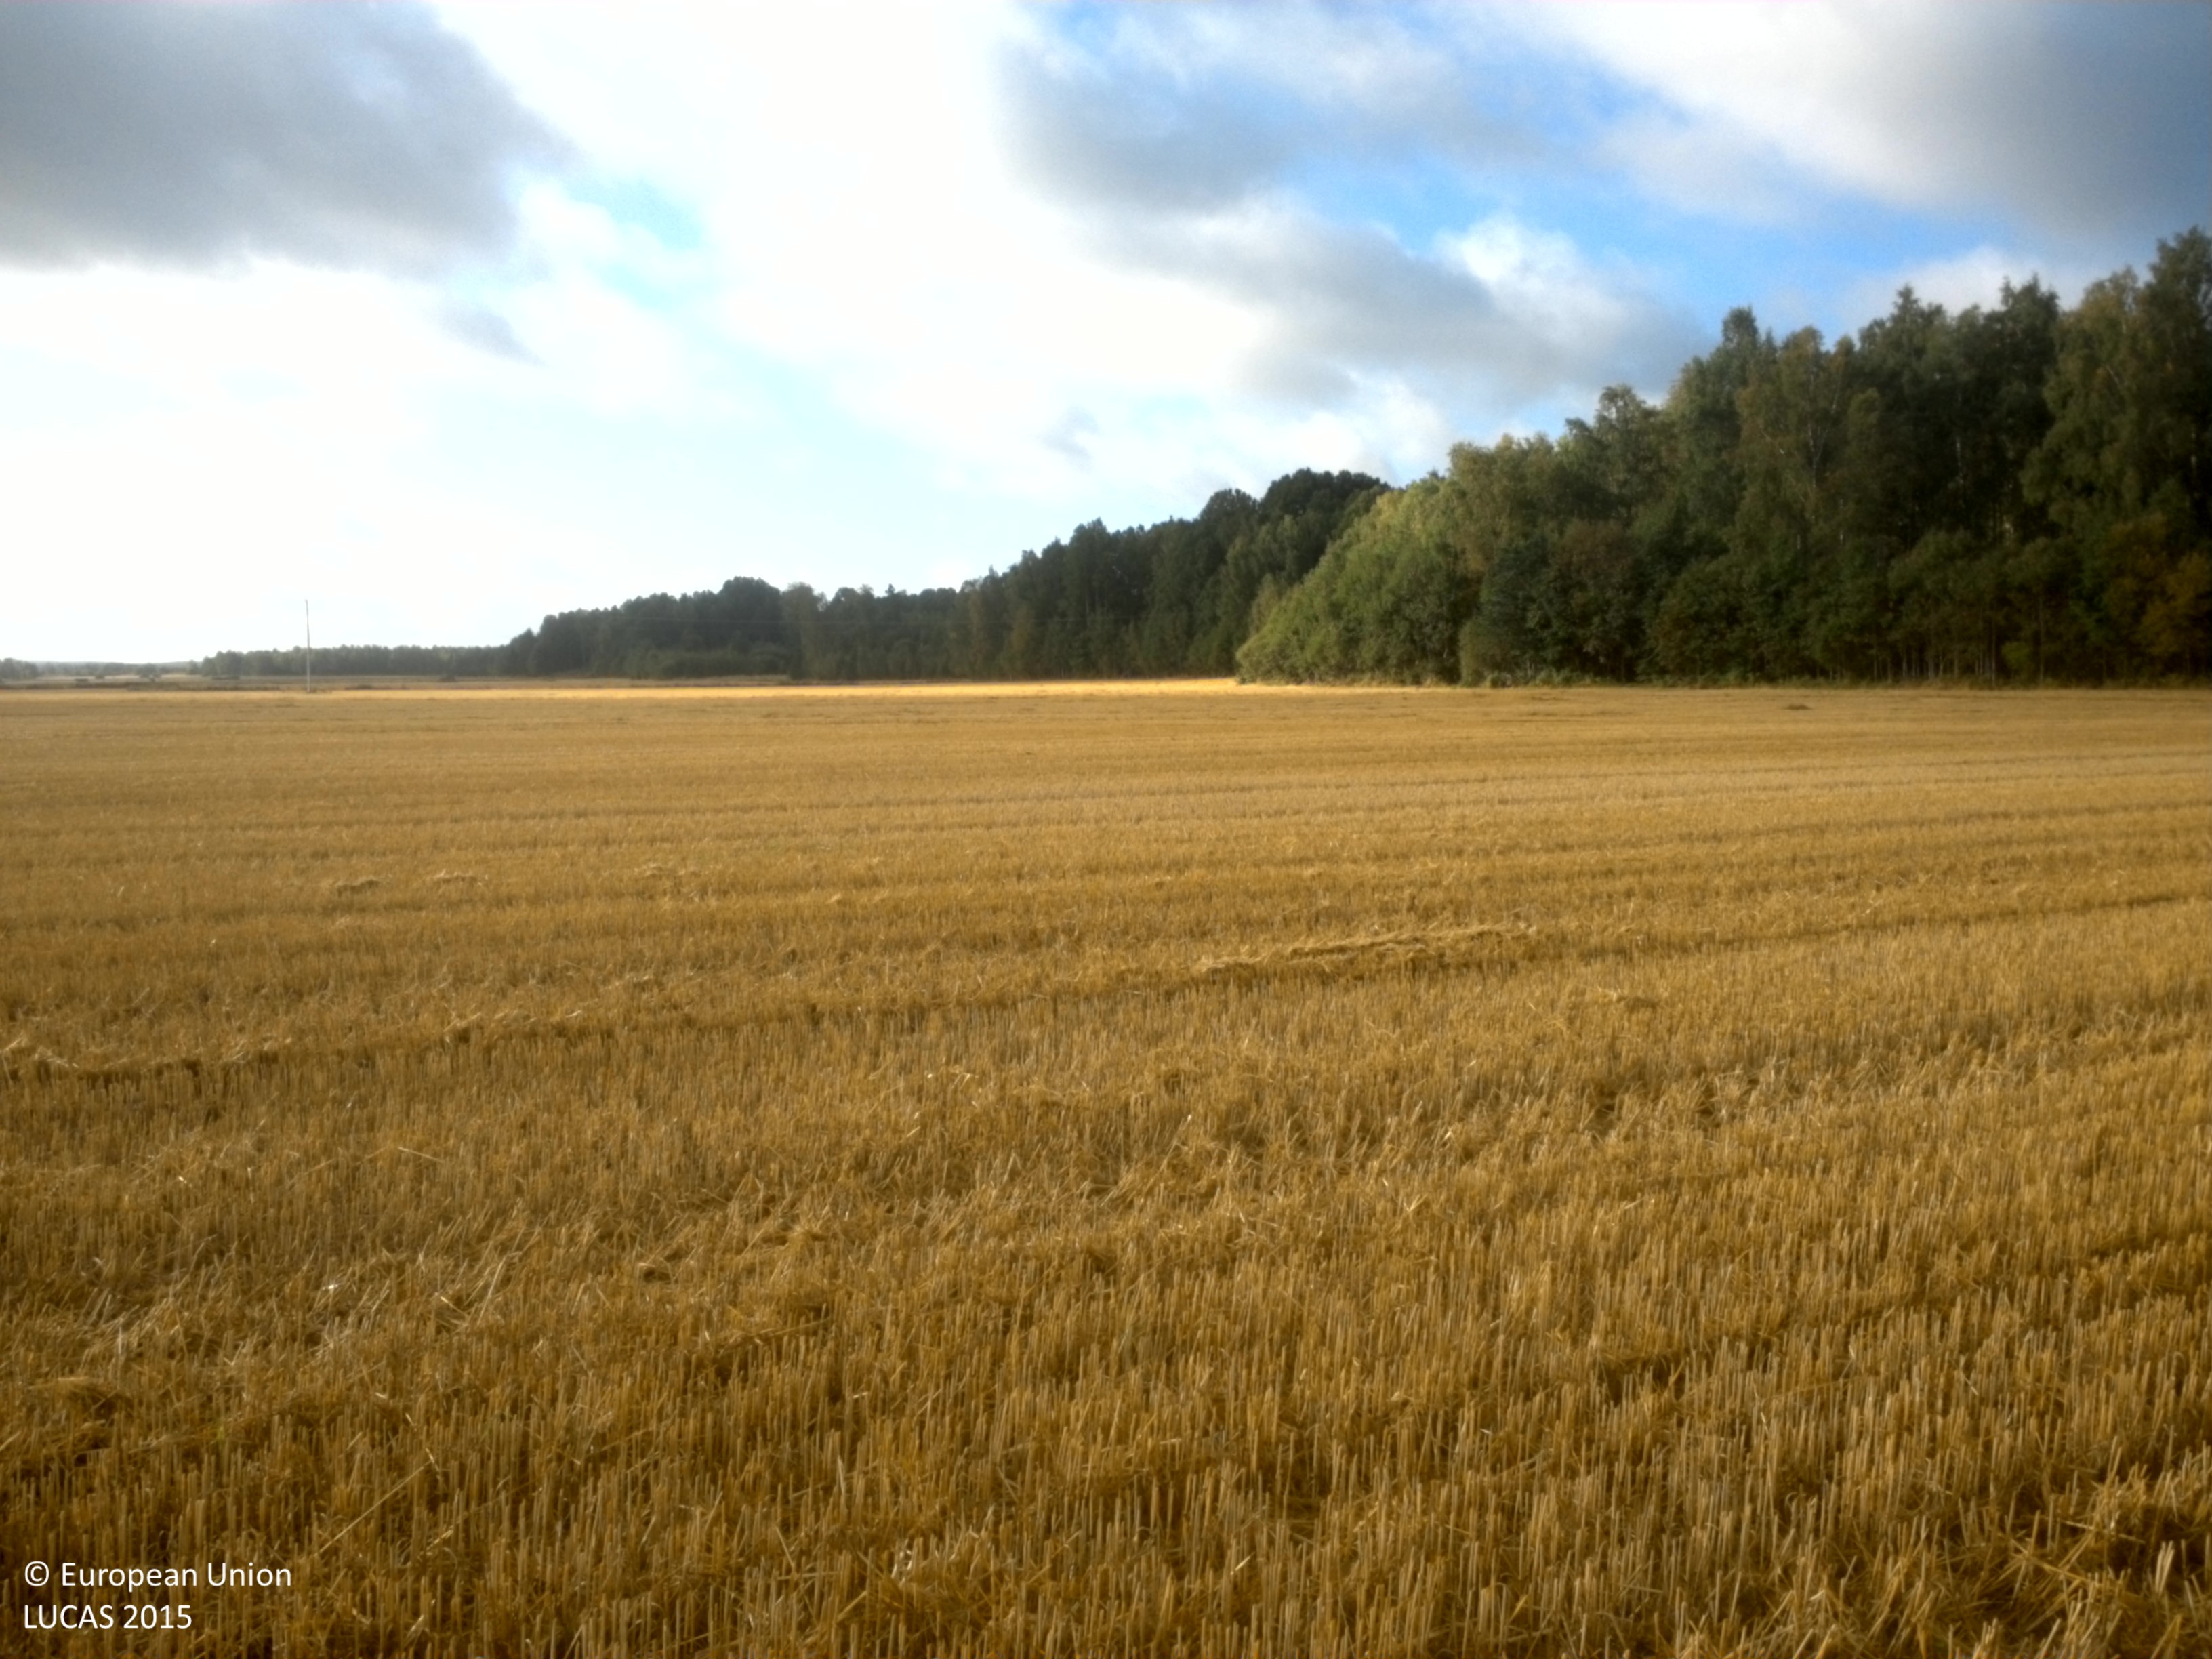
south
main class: Cropland
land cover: Common wheat
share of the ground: > 75 %
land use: Agriculture (excluding fallow land and kitchen gardens)
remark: Harvested field
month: August
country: SE
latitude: 59.5151
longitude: 15.9116
